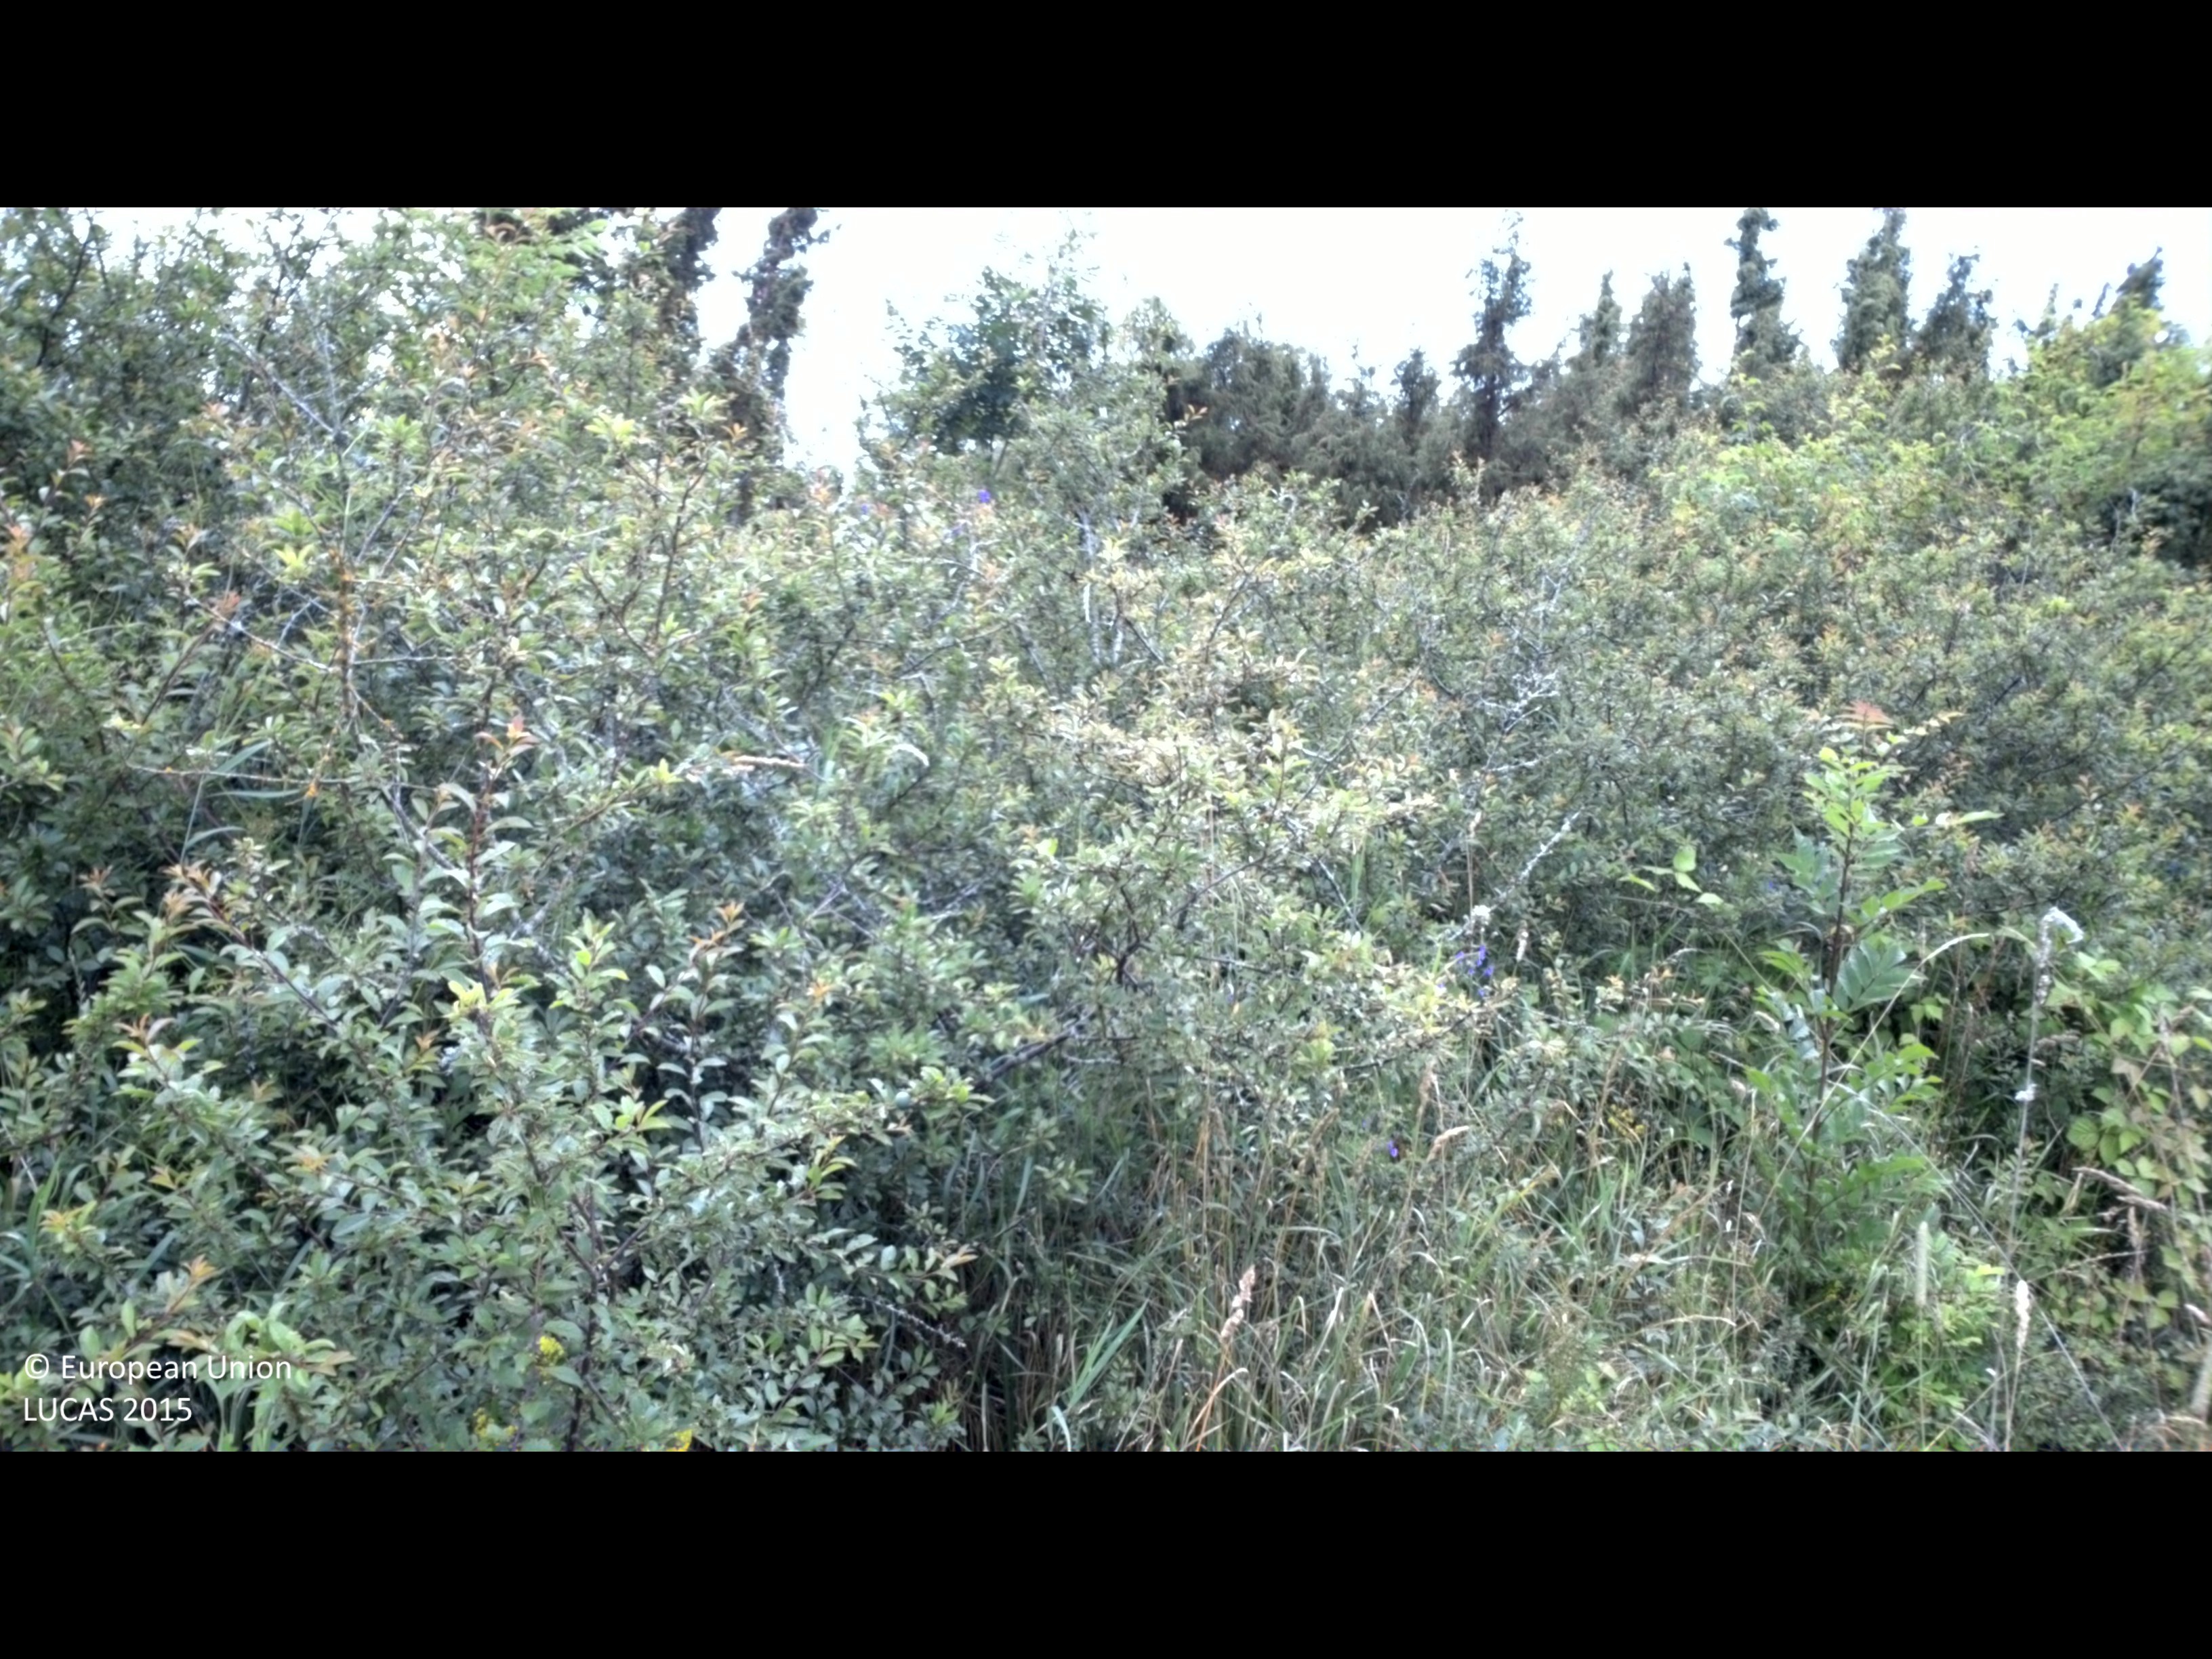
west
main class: Shrubland
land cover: Shrubland without tree cover
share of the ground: > 75 %
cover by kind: shrubs 100 %
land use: Semi-natural and natural areas not in use
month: July
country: SE
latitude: 57.1167
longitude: 16.9876
